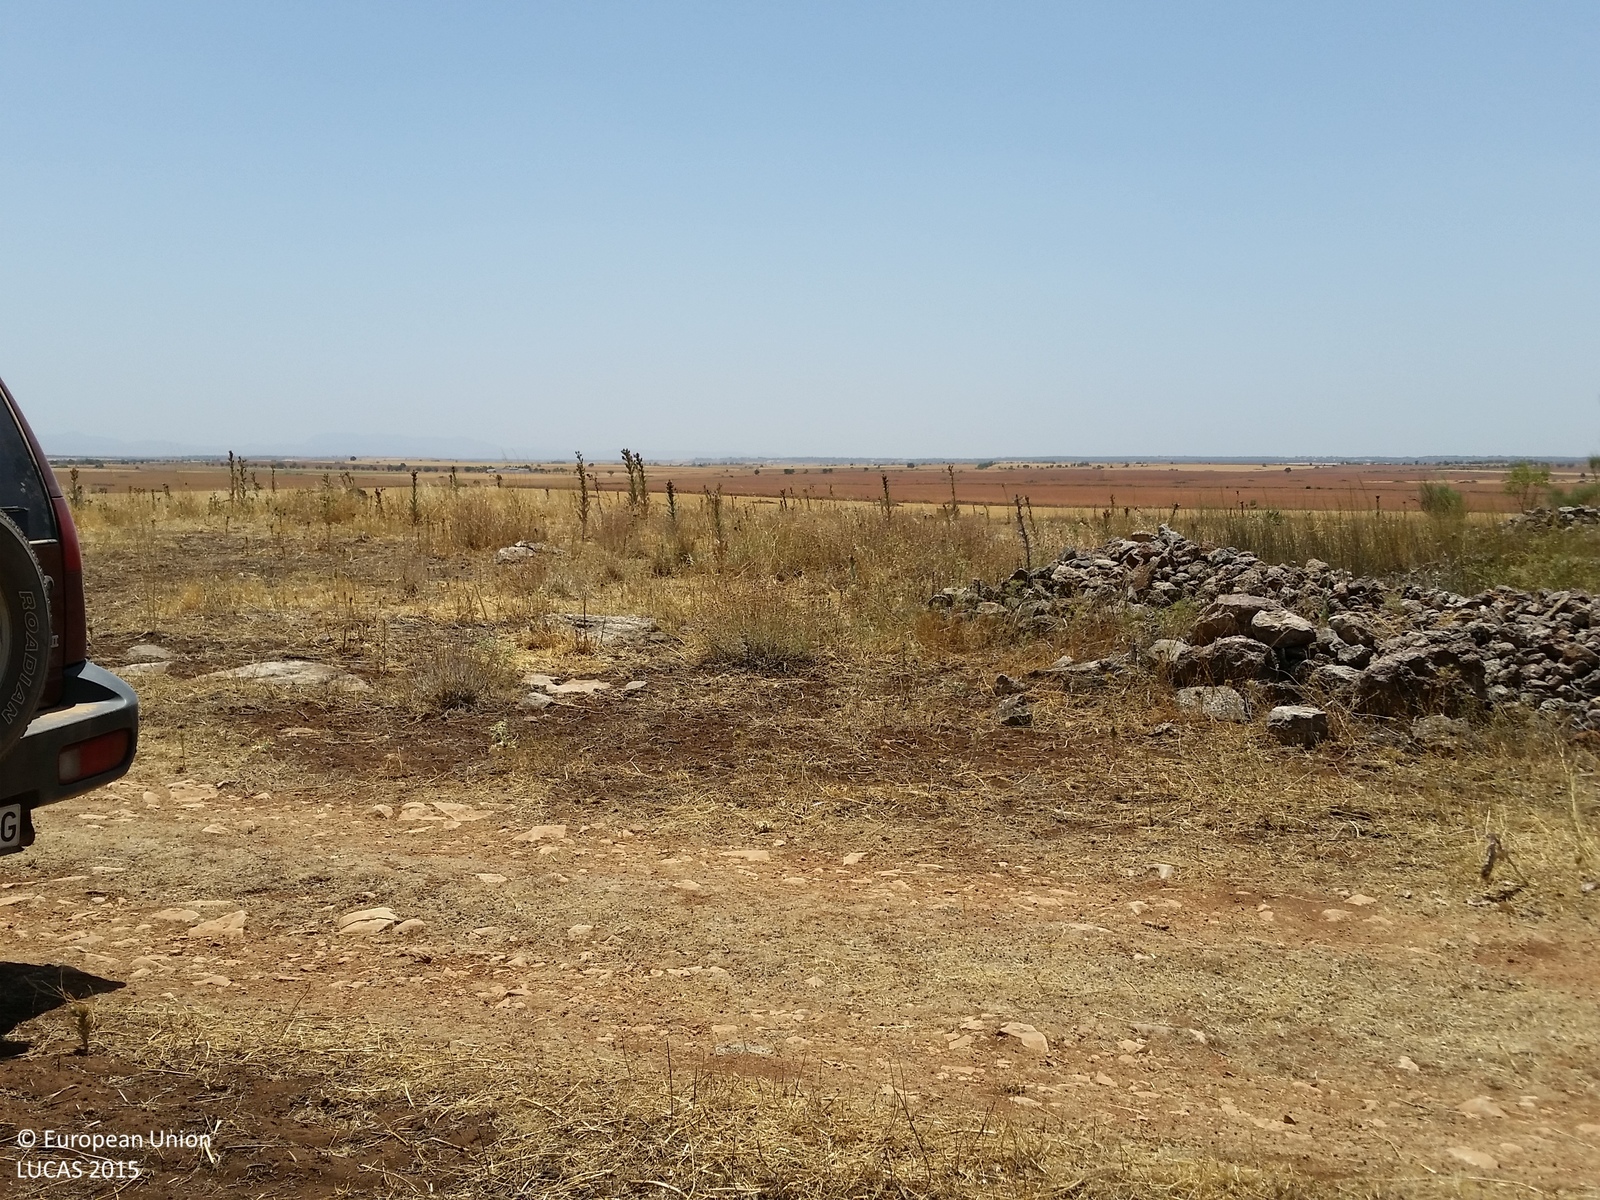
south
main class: Cropland
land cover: Barley
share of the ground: < 10 %
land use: Agriculture (excluding fallow land and kitchen gardens)
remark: Harvested field
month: July
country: ES
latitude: 38.8687
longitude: -2.5788
